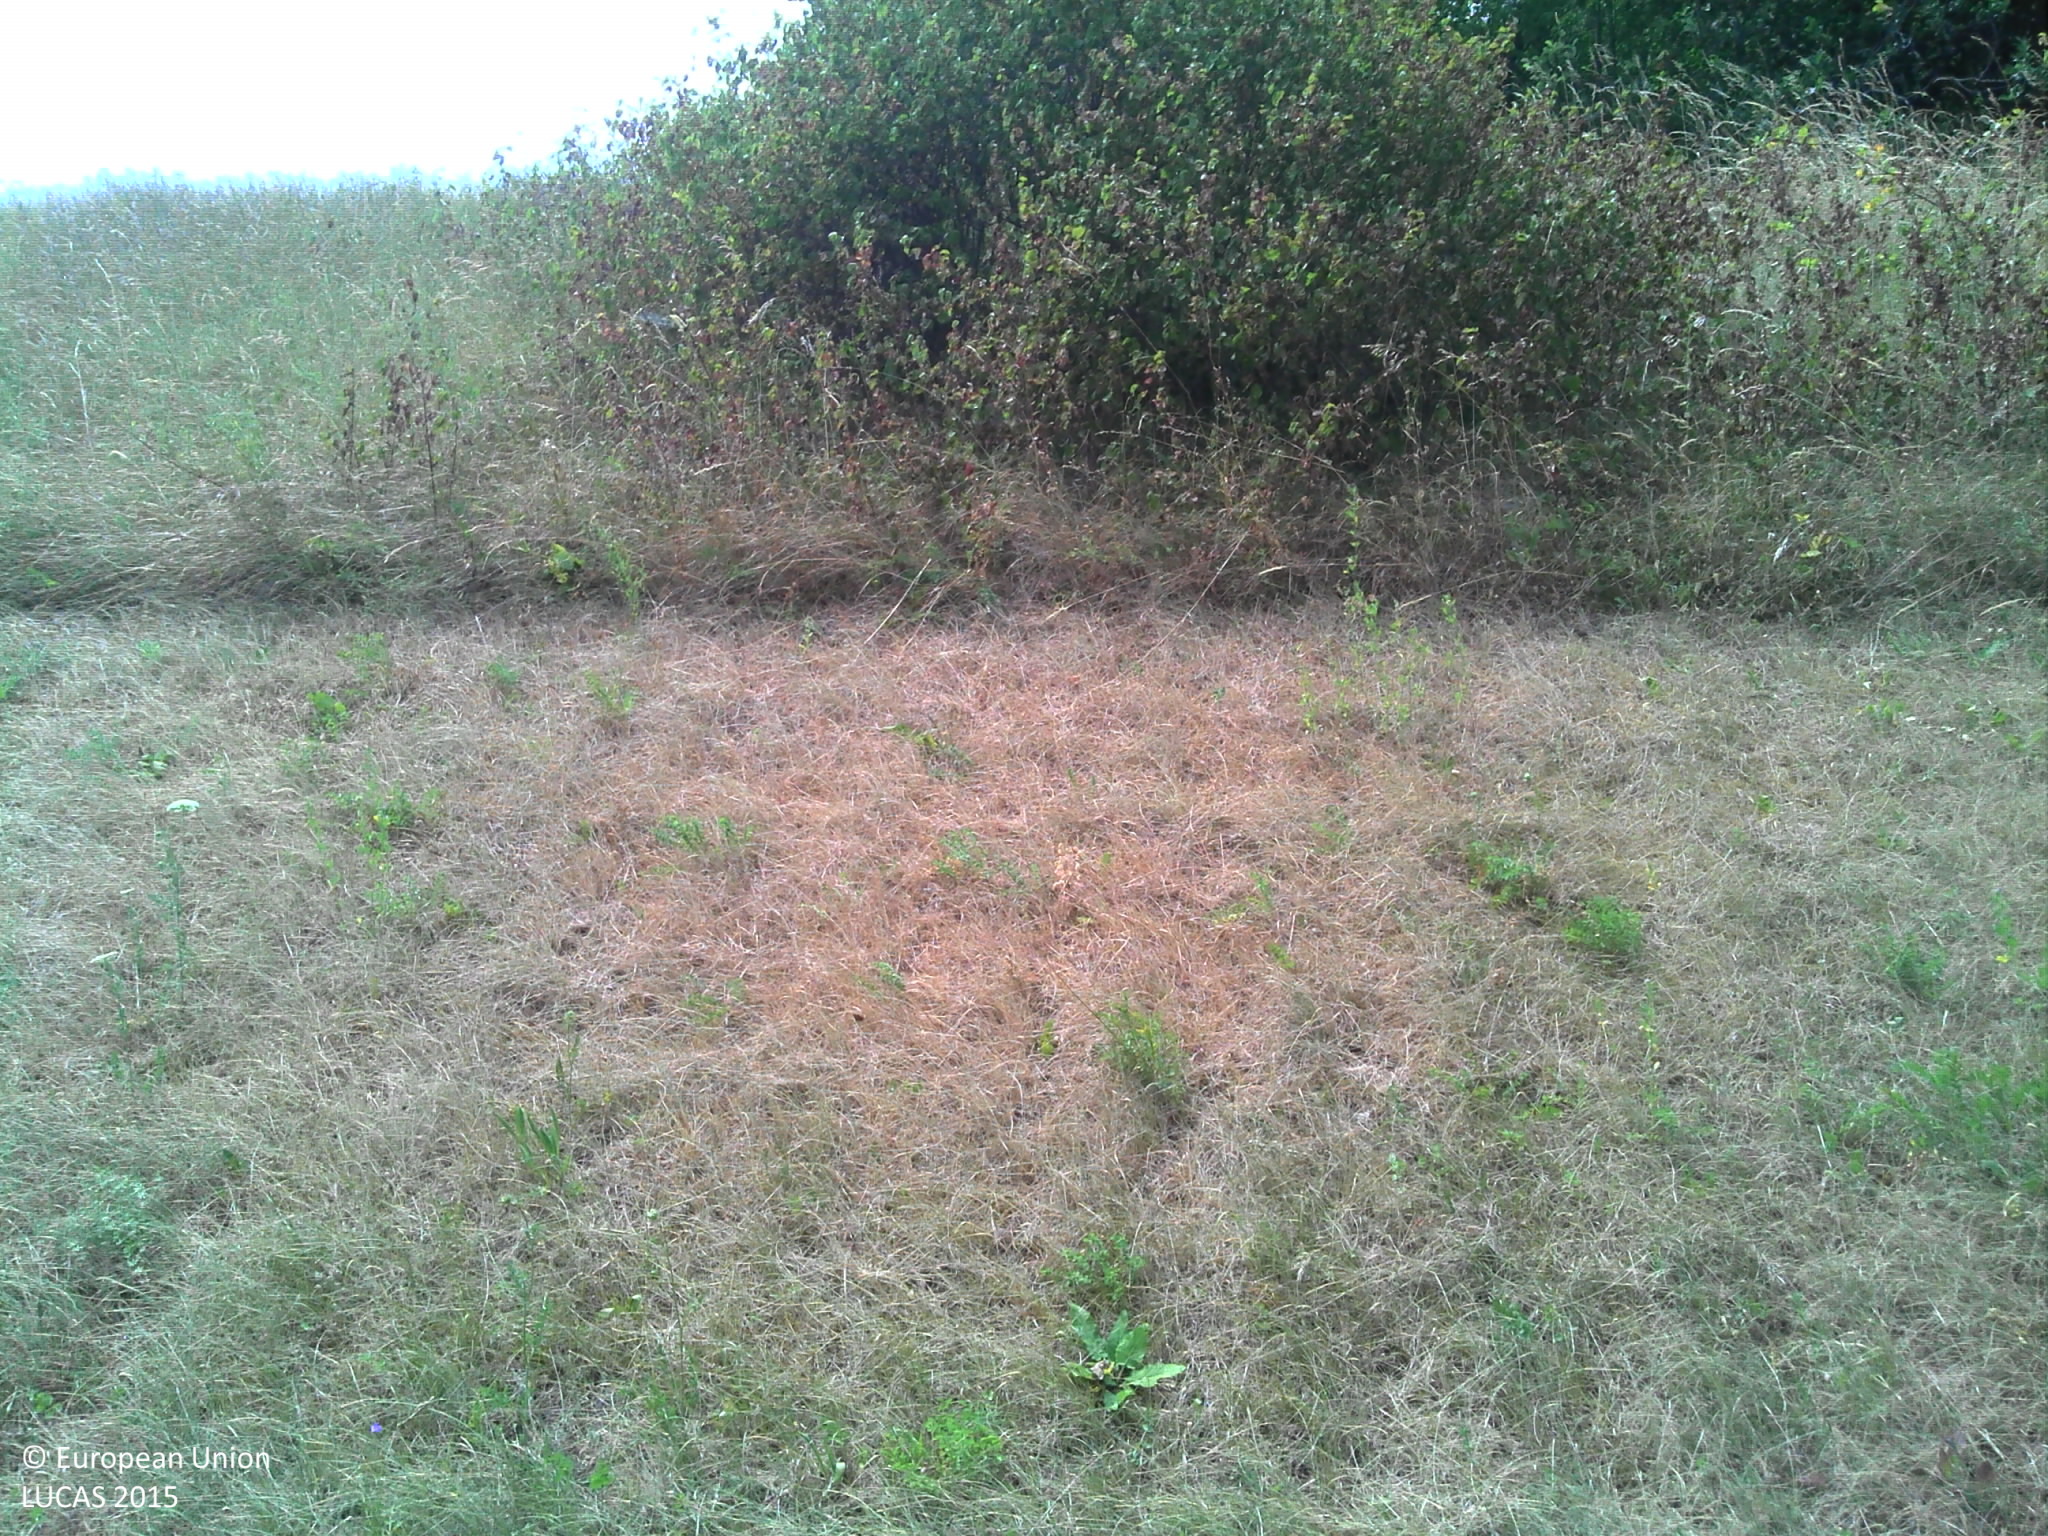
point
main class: Grassland
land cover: Grassland with sparse tree/shrub cover
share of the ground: > 75 %
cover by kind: herbaceous plants 90 %, broadleaved forest trees 5 %, shrubs 5 %
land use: Semi-natural and natural areas not in use
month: July
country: FR
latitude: 45.8151
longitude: 6.2076
